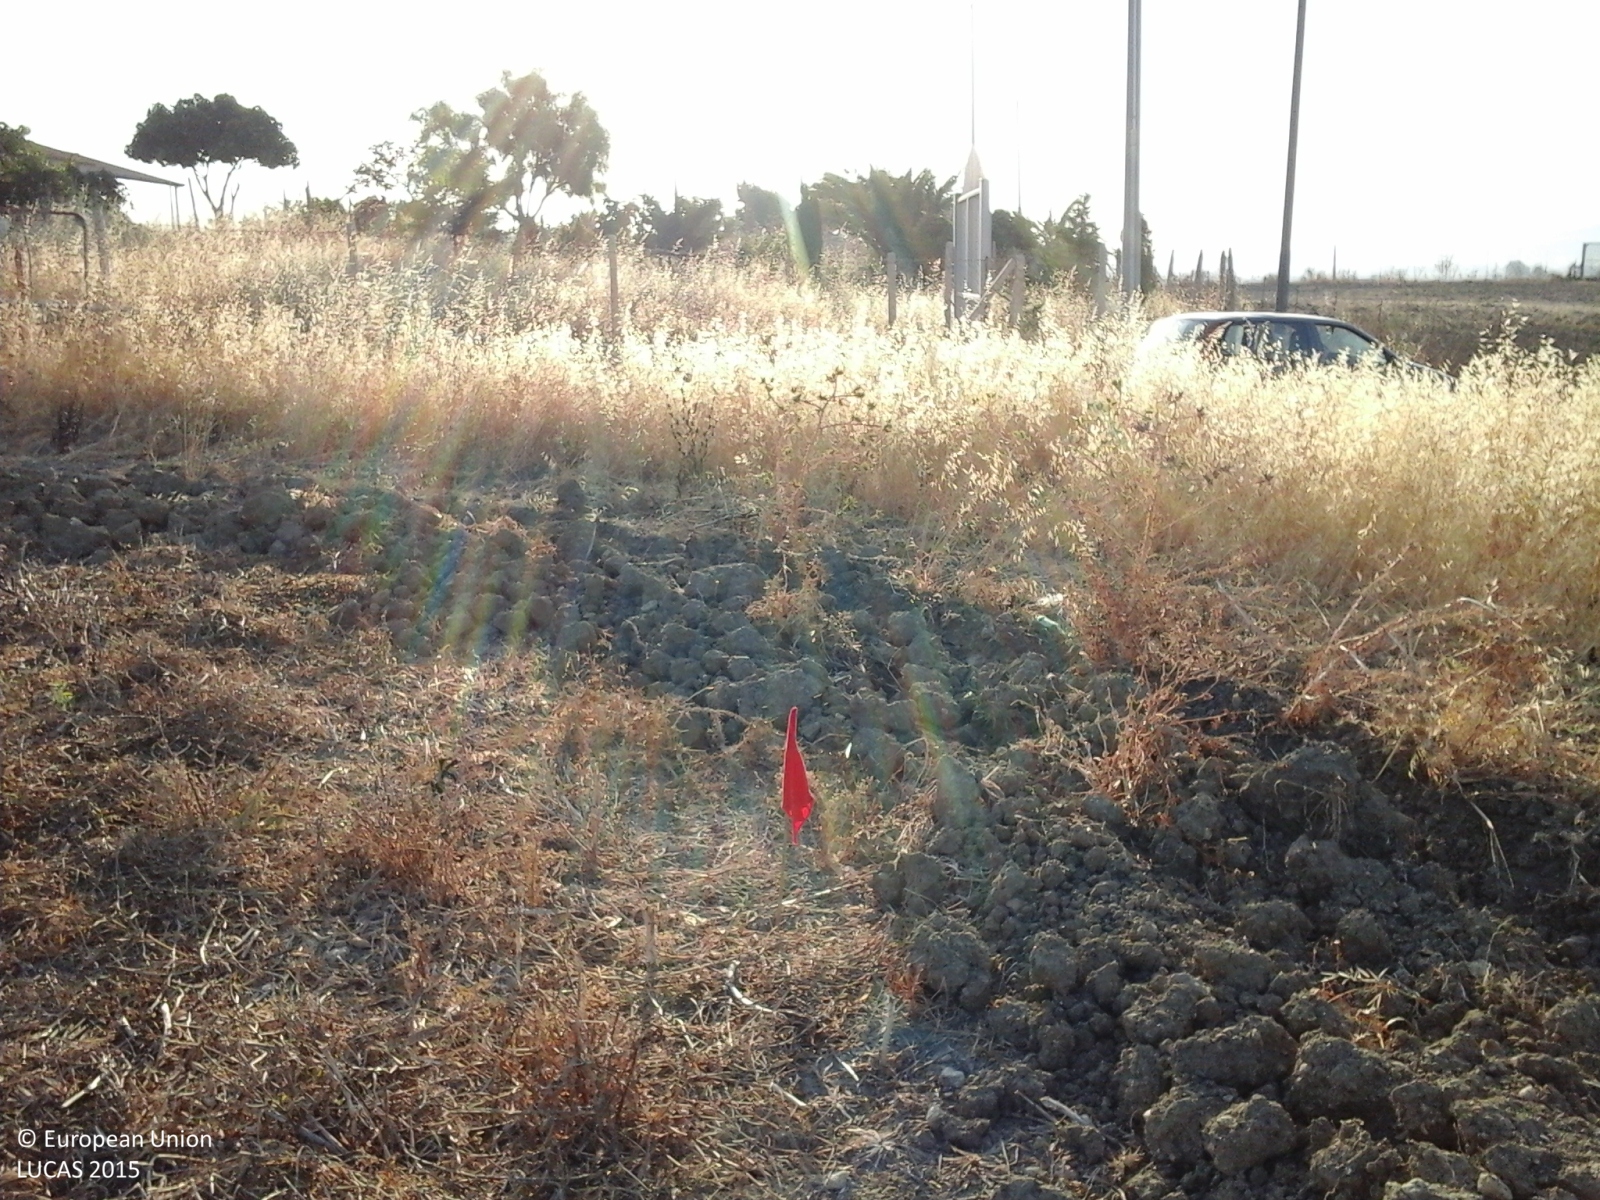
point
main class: Cropland
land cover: Other leguminous and mixtures for fodder
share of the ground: > 75 %
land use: Agriculture (excluding fallow land and kitchen gardens)
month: July
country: IT
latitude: 37.1138
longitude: 14.0978
